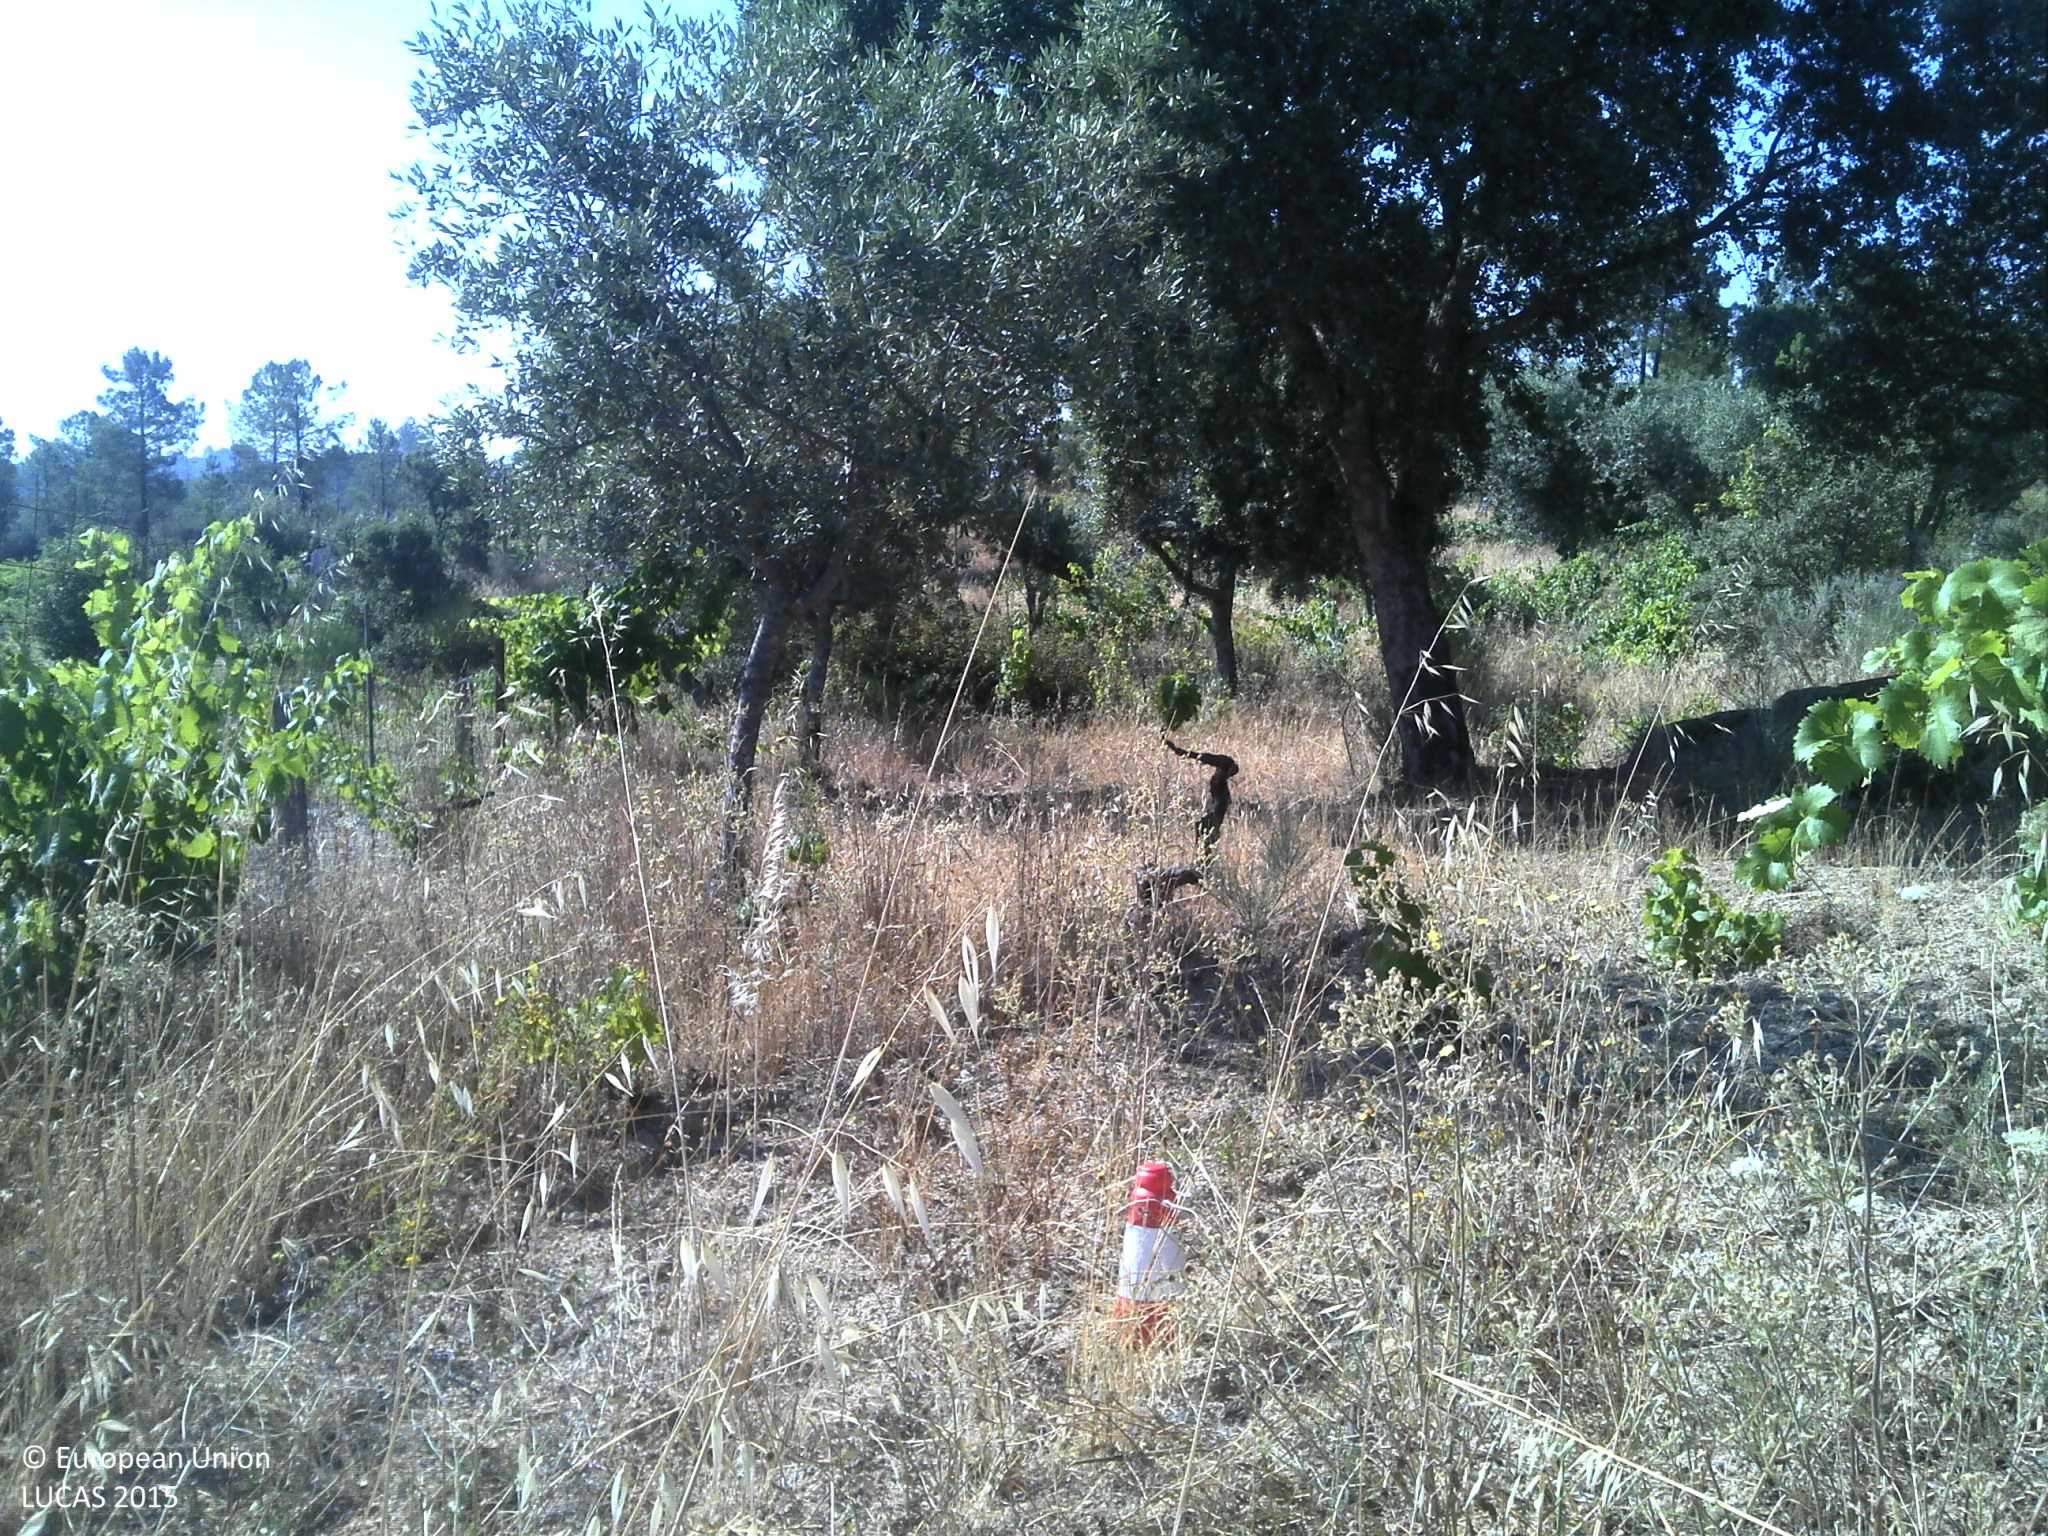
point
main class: Cropland
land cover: Olive groves
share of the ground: 25 - 50 %
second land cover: Vineyards
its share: 10 - 25 %
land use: Agriculture (excluding fallow land and kitchen gardens)
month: June
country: PT
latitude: 39.8702
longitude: -7.5563
